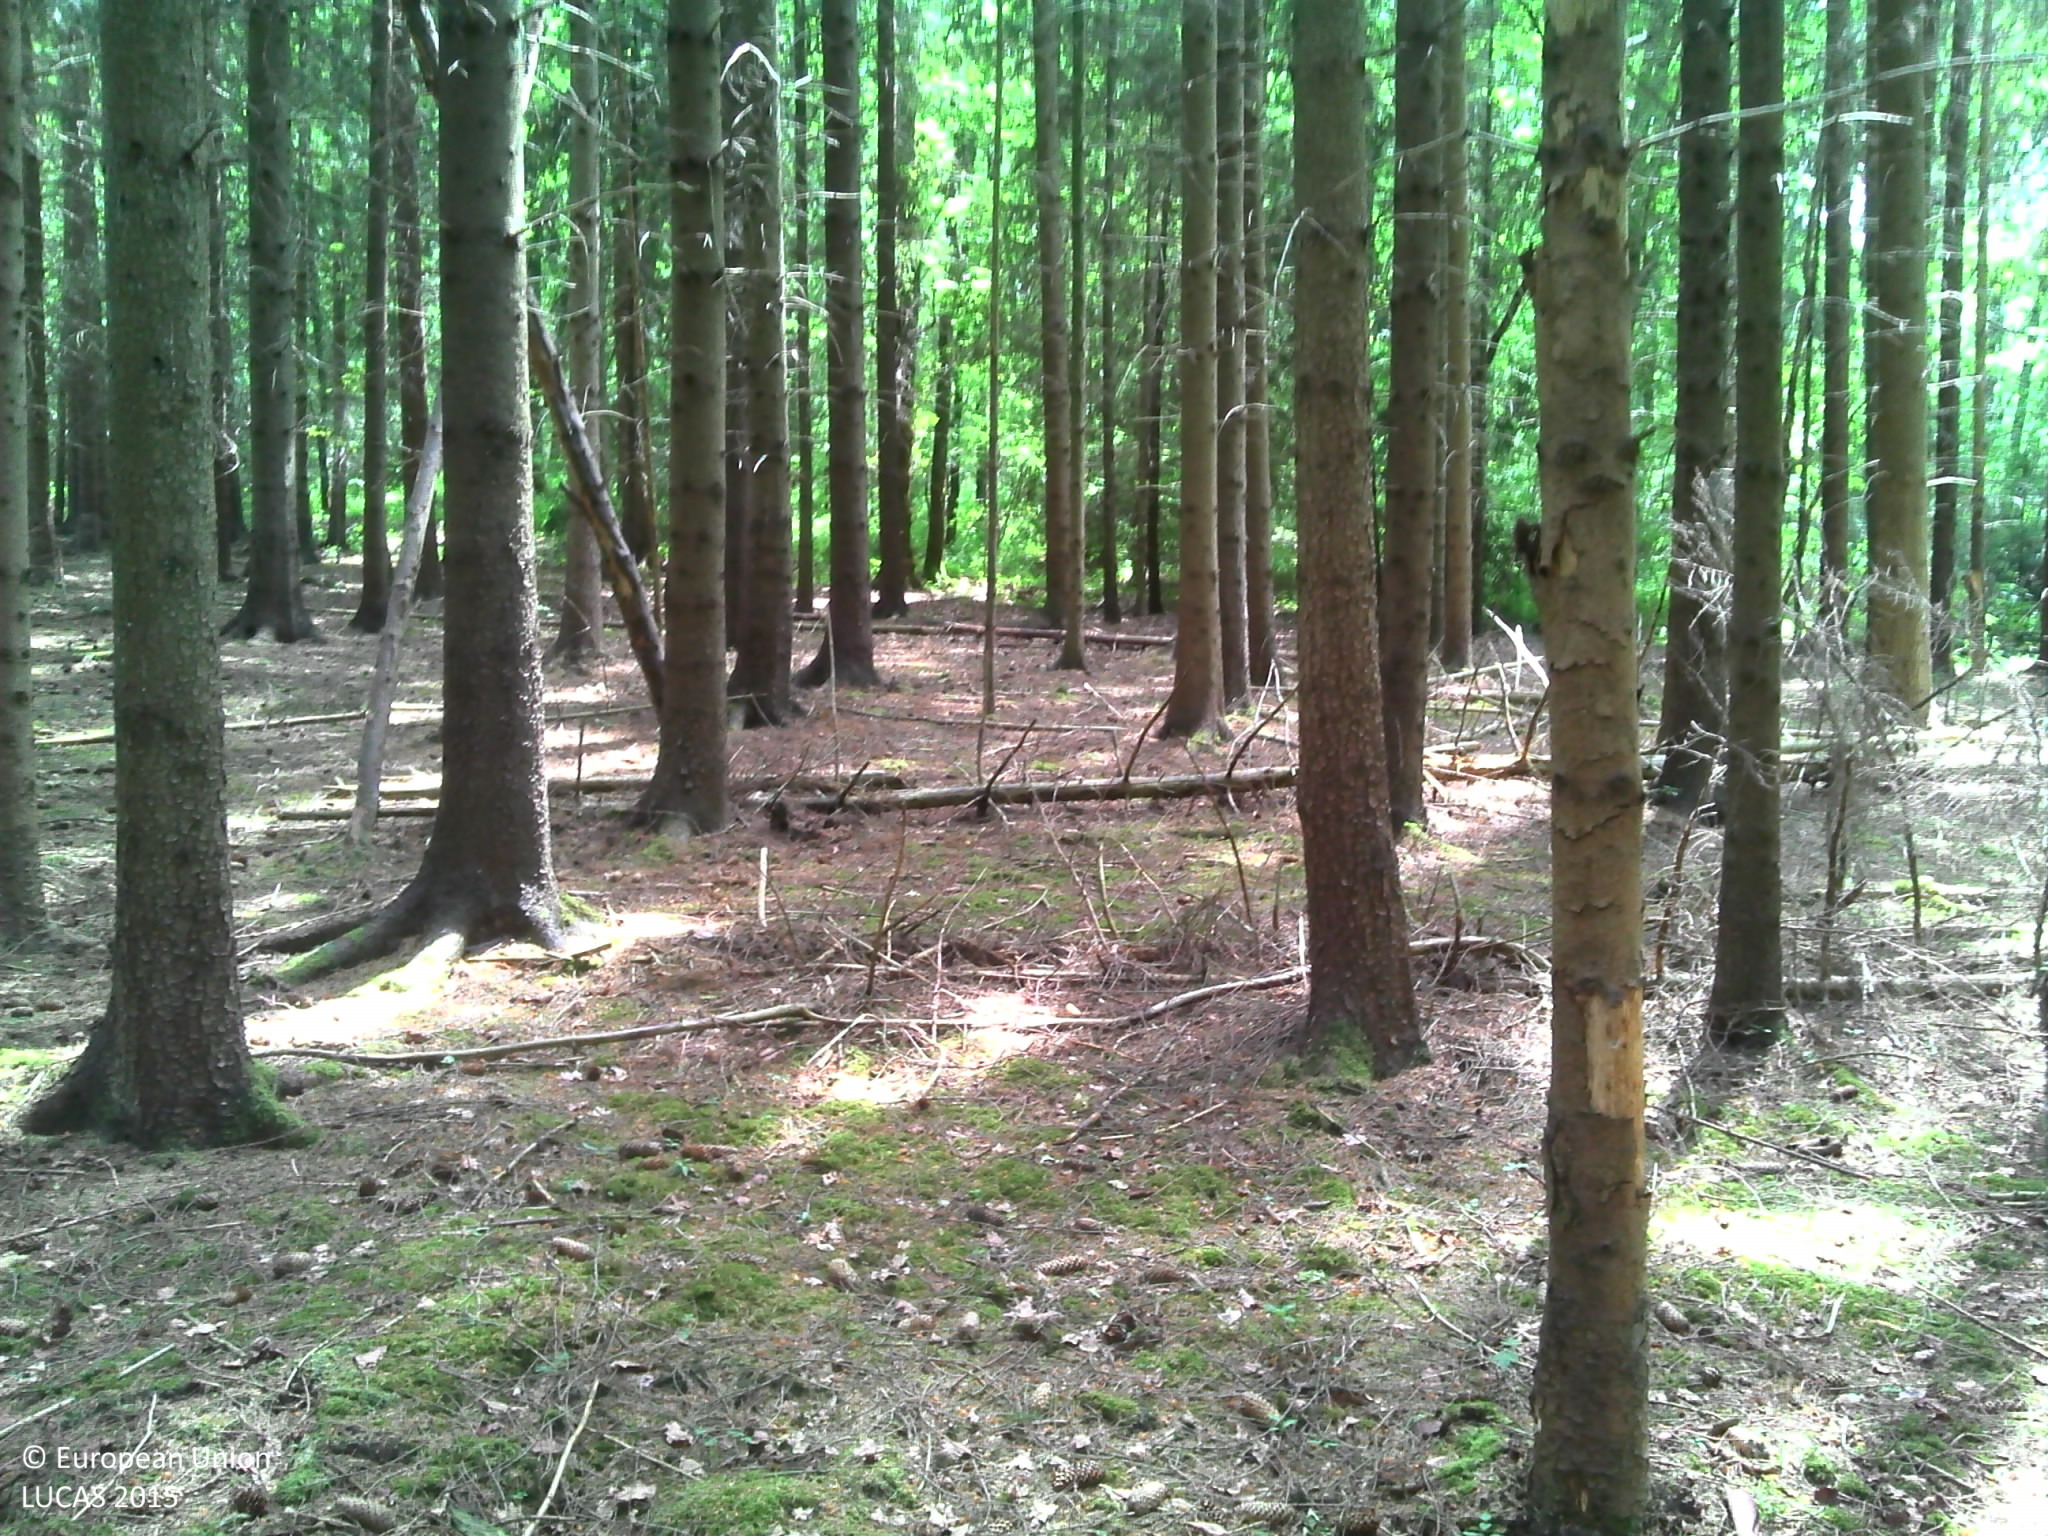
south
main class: Woodland
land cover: Spruce dominated coniferous woodland
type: exotic forest
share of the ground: > 75 %
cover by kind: coniferous forest trees 95 %, broadleaved forest trees 5 %
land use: Forestry
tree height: > 5 m
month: June
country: BE
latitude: 50.3291
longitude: 5.4890
